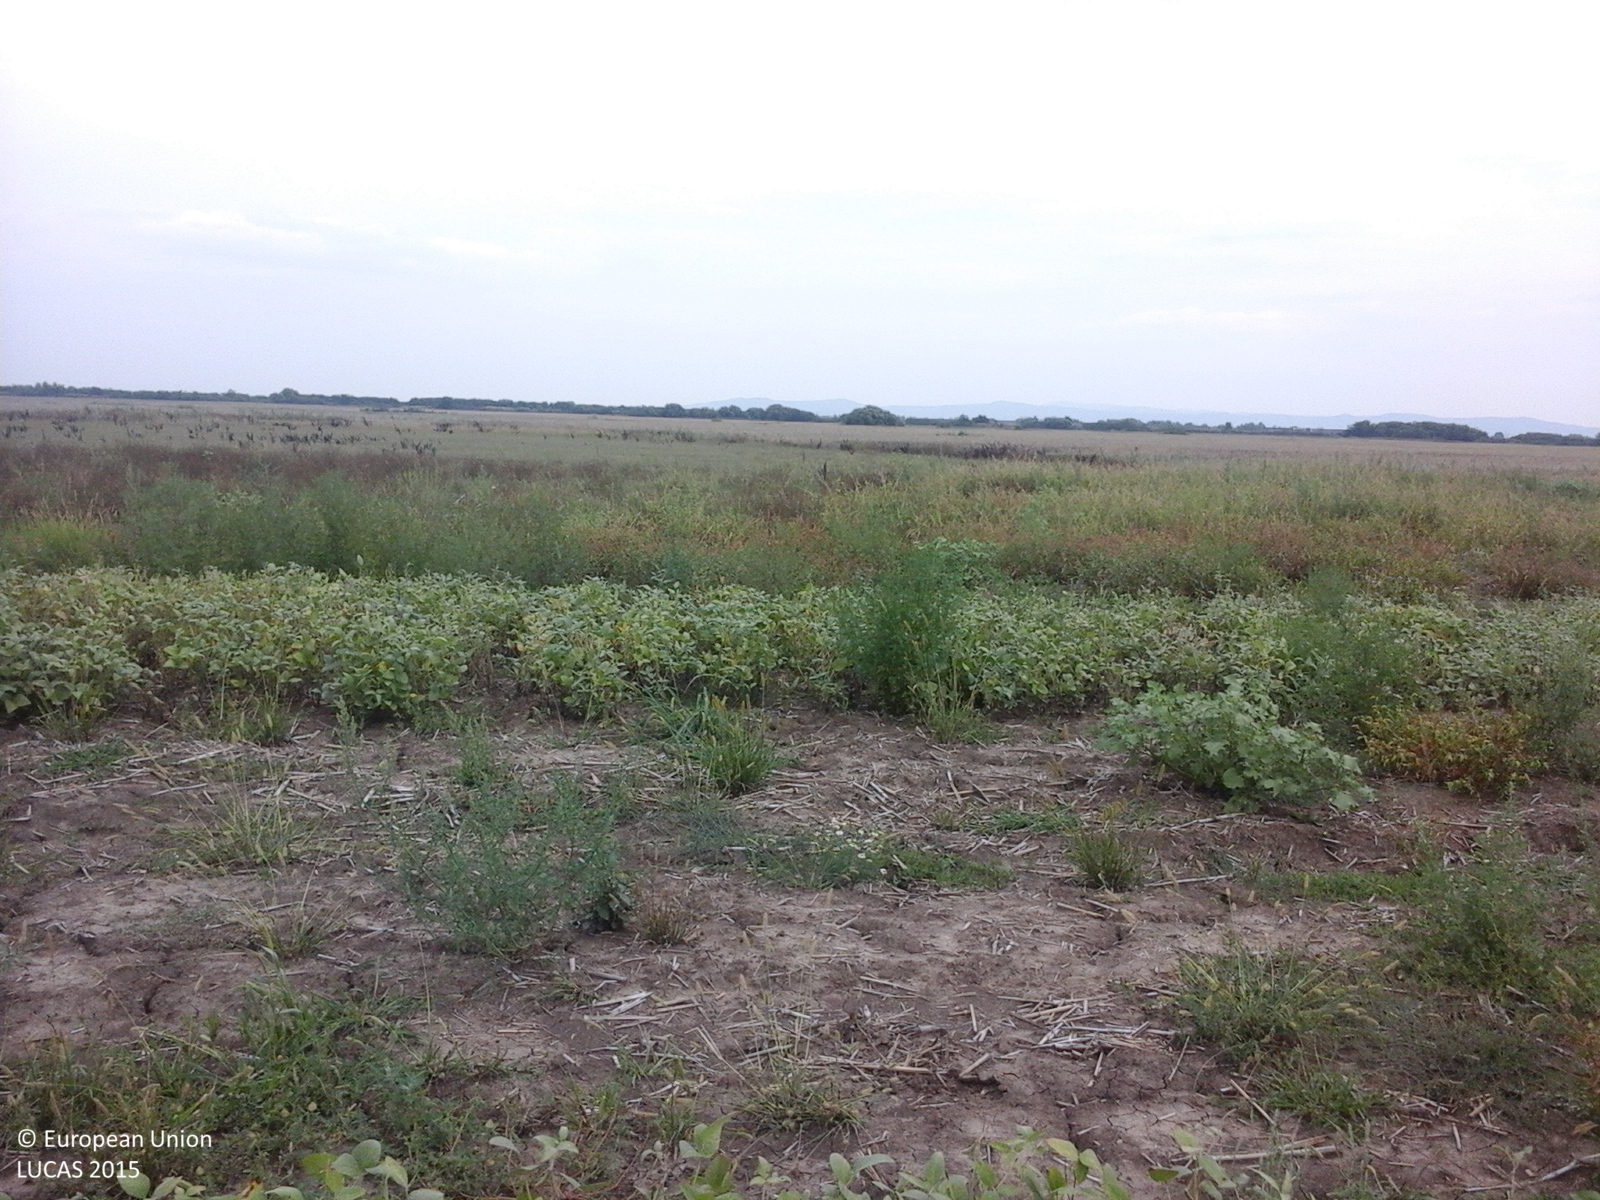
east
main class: Cropland
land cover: Soya
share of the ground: > 75 %
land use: Agriculture (excluding fallow land and kitchen gardens)
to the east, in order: Soya; Spontaneously vegetated surfaces; Rape and turnip rape
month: August
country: RO
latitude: 46.2558
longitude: 21.3334
